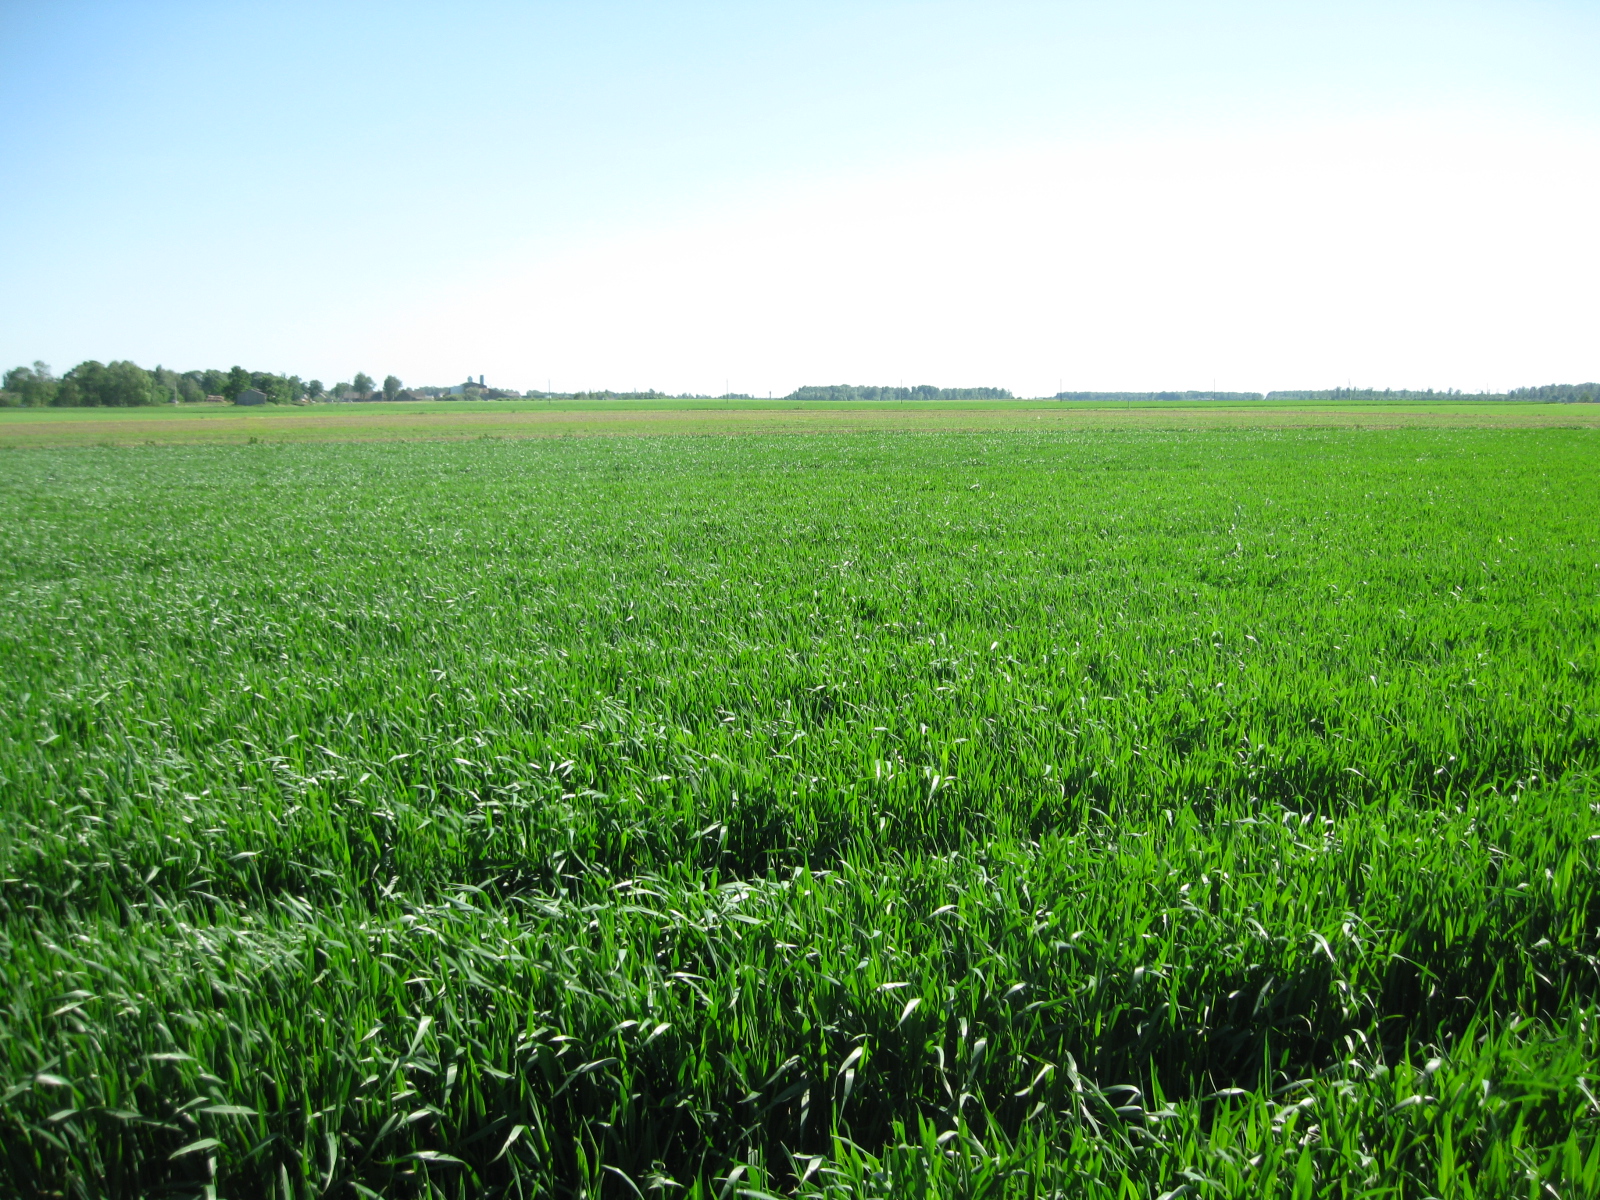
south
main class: Cropland
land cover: Common wheat
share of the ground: > 75 %
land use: Agriculture (excluding fallow land and kitchen gardens)
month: June
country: LT
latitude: 55.8674
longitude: 23.8760
